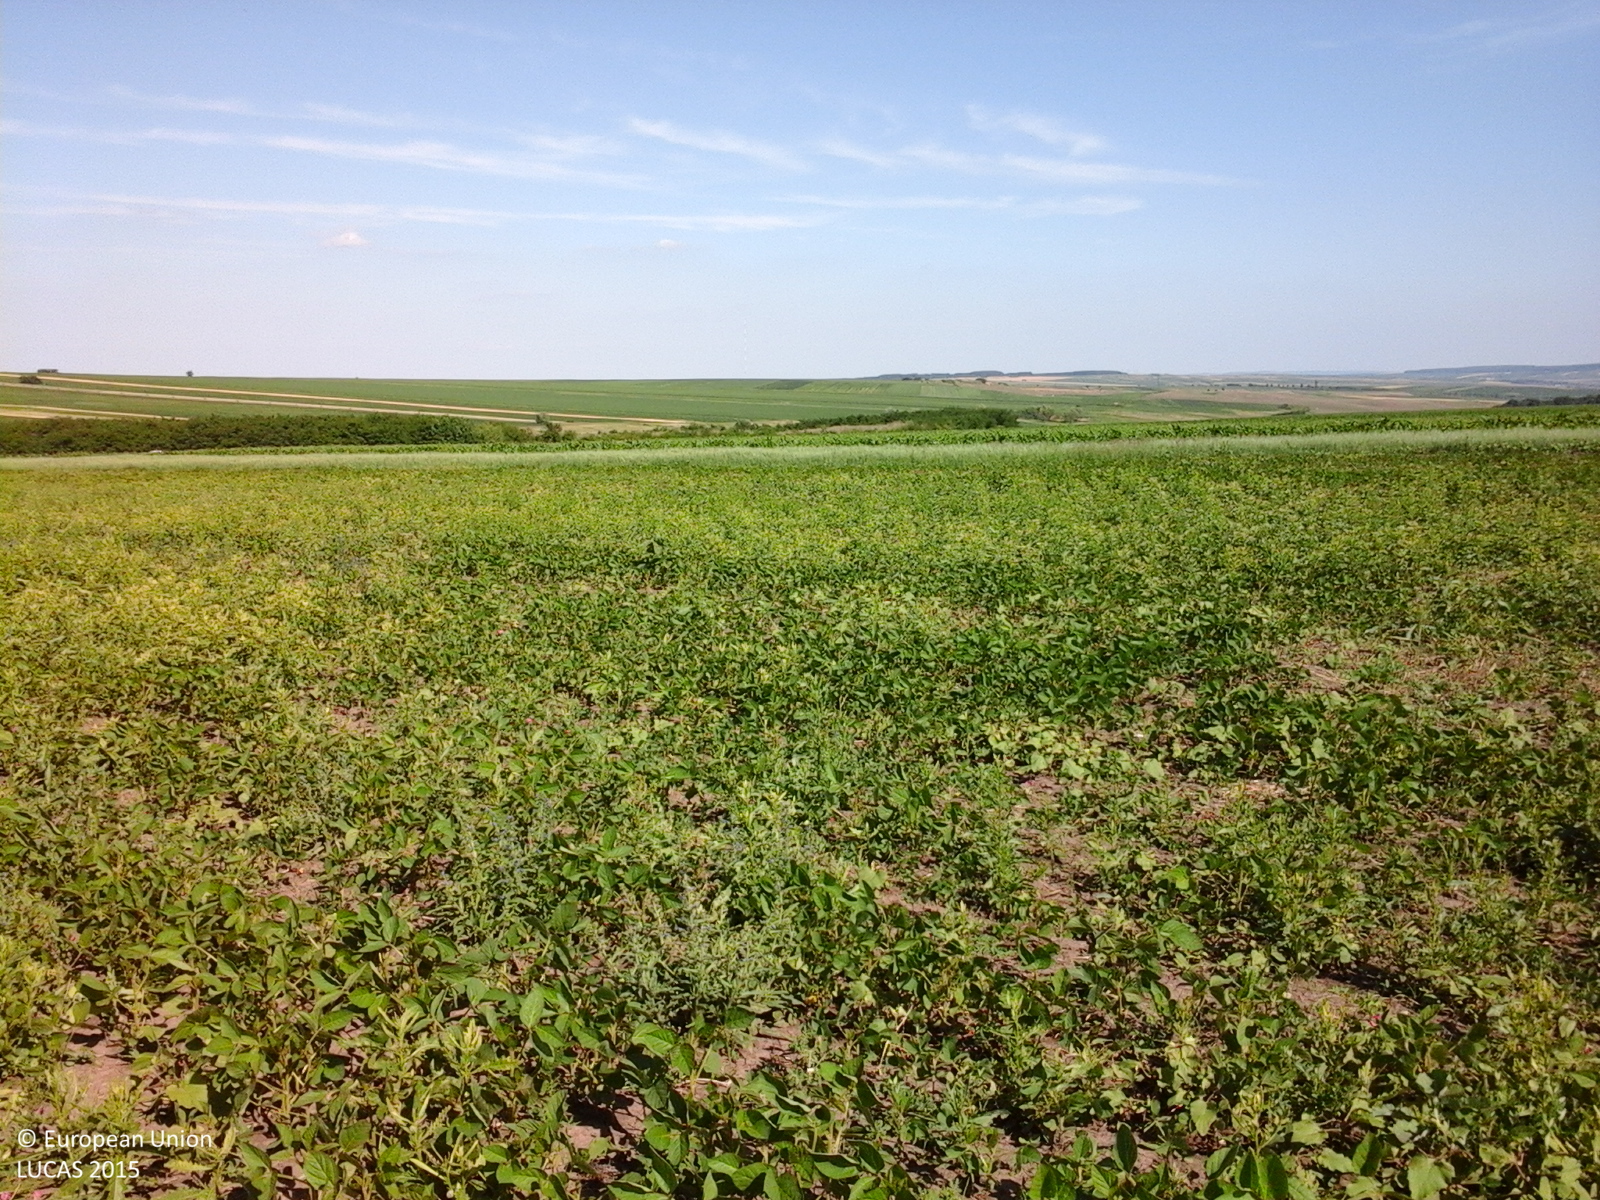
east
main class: Cropland
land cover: Soya
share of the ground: > 75 %
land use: Agriculture (excluding fallow land and kitchen gardens)
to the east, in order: Soya; Oats; Maize; Grass margins; Sunflower
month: June
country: RO
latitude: 48.0747
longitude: 26.9499
